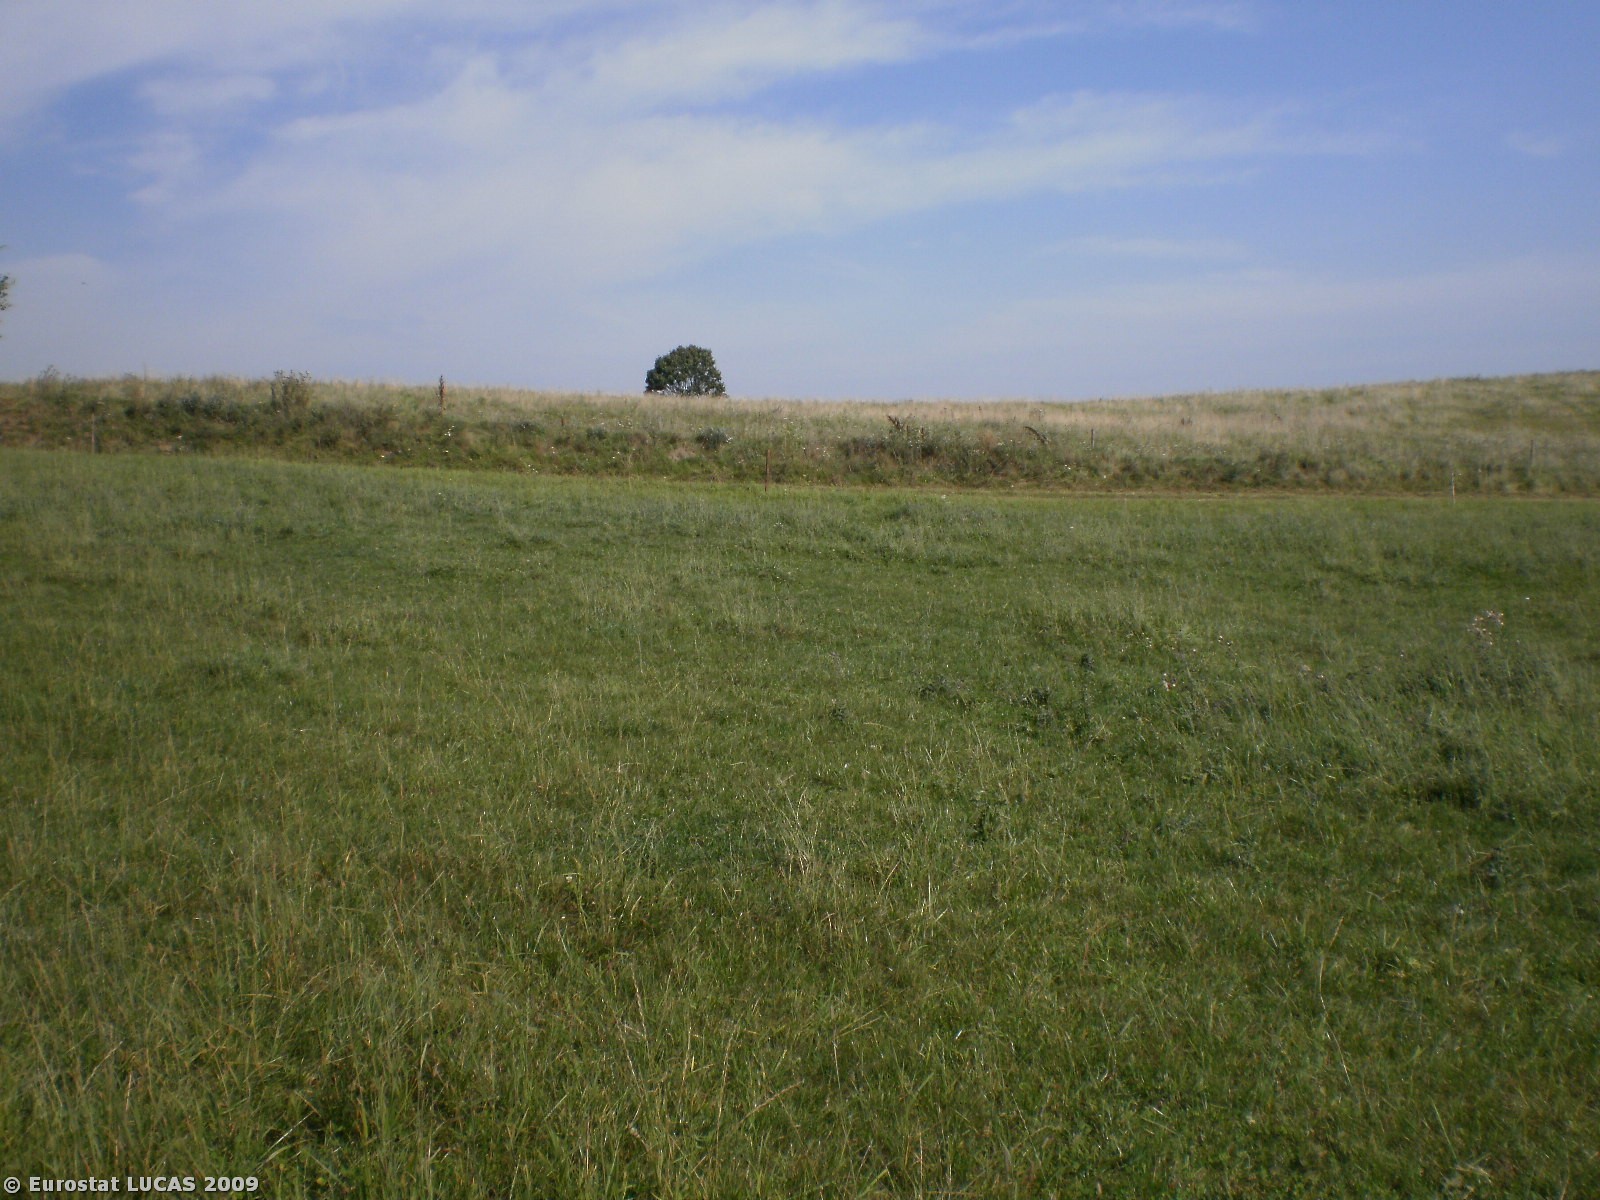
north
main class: Grassland
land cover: Grassland without tree/shrub cover
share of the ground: > 75 %
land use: Agriculture (excluding fallow land and kitchen gardens)
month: August
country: PL
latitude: 53.9937
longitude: 21.7214
